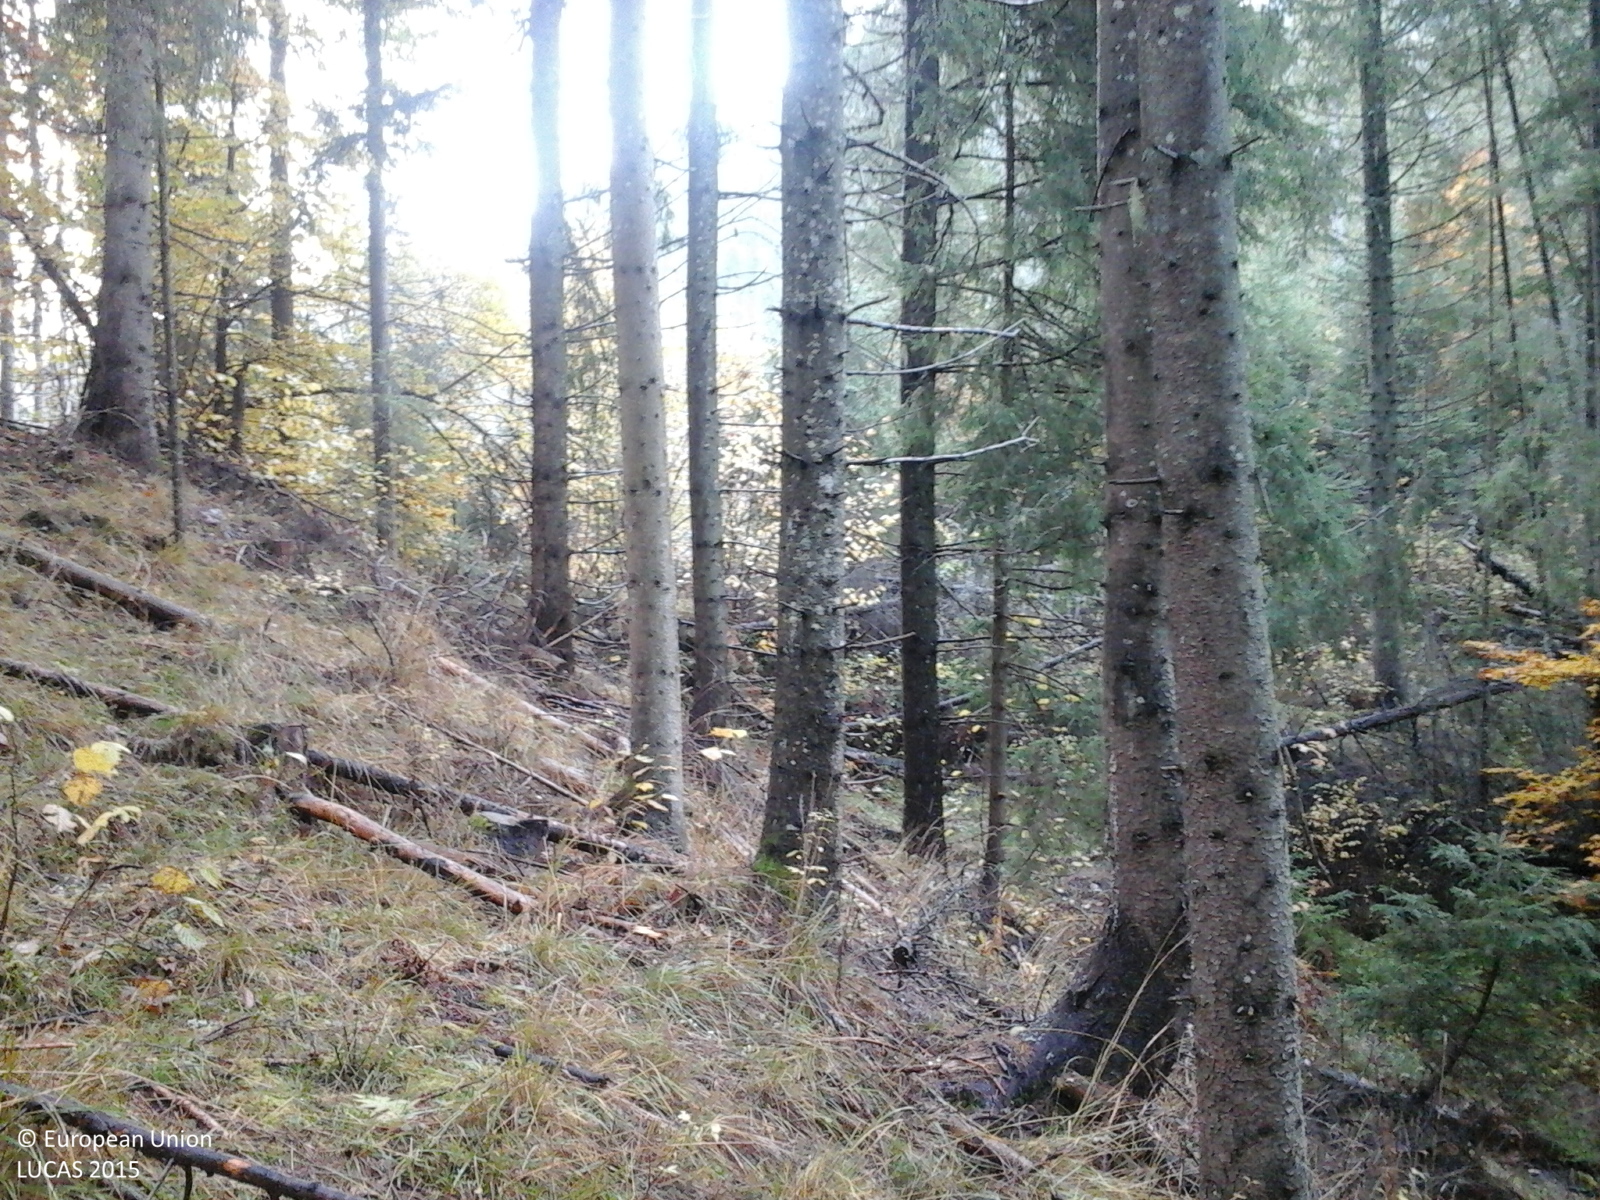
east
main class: Woodland
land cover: Spruce dominated coniferous woodland
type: alpine coniferous forest
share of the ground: > 75 %
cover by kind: coniferous forest trees 100 %
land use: Forestry
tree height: > 5 m
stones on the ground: > 50 %
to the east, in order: Spruce dominated coniferous woodland; Grassland with sparse tree/shrub cover; Tracks; Grassland with sparse tree/shrub cover; Broadleaved woodland; Inland fresh running water
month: October
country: RO
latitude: 47.0516
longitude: 25.5824
